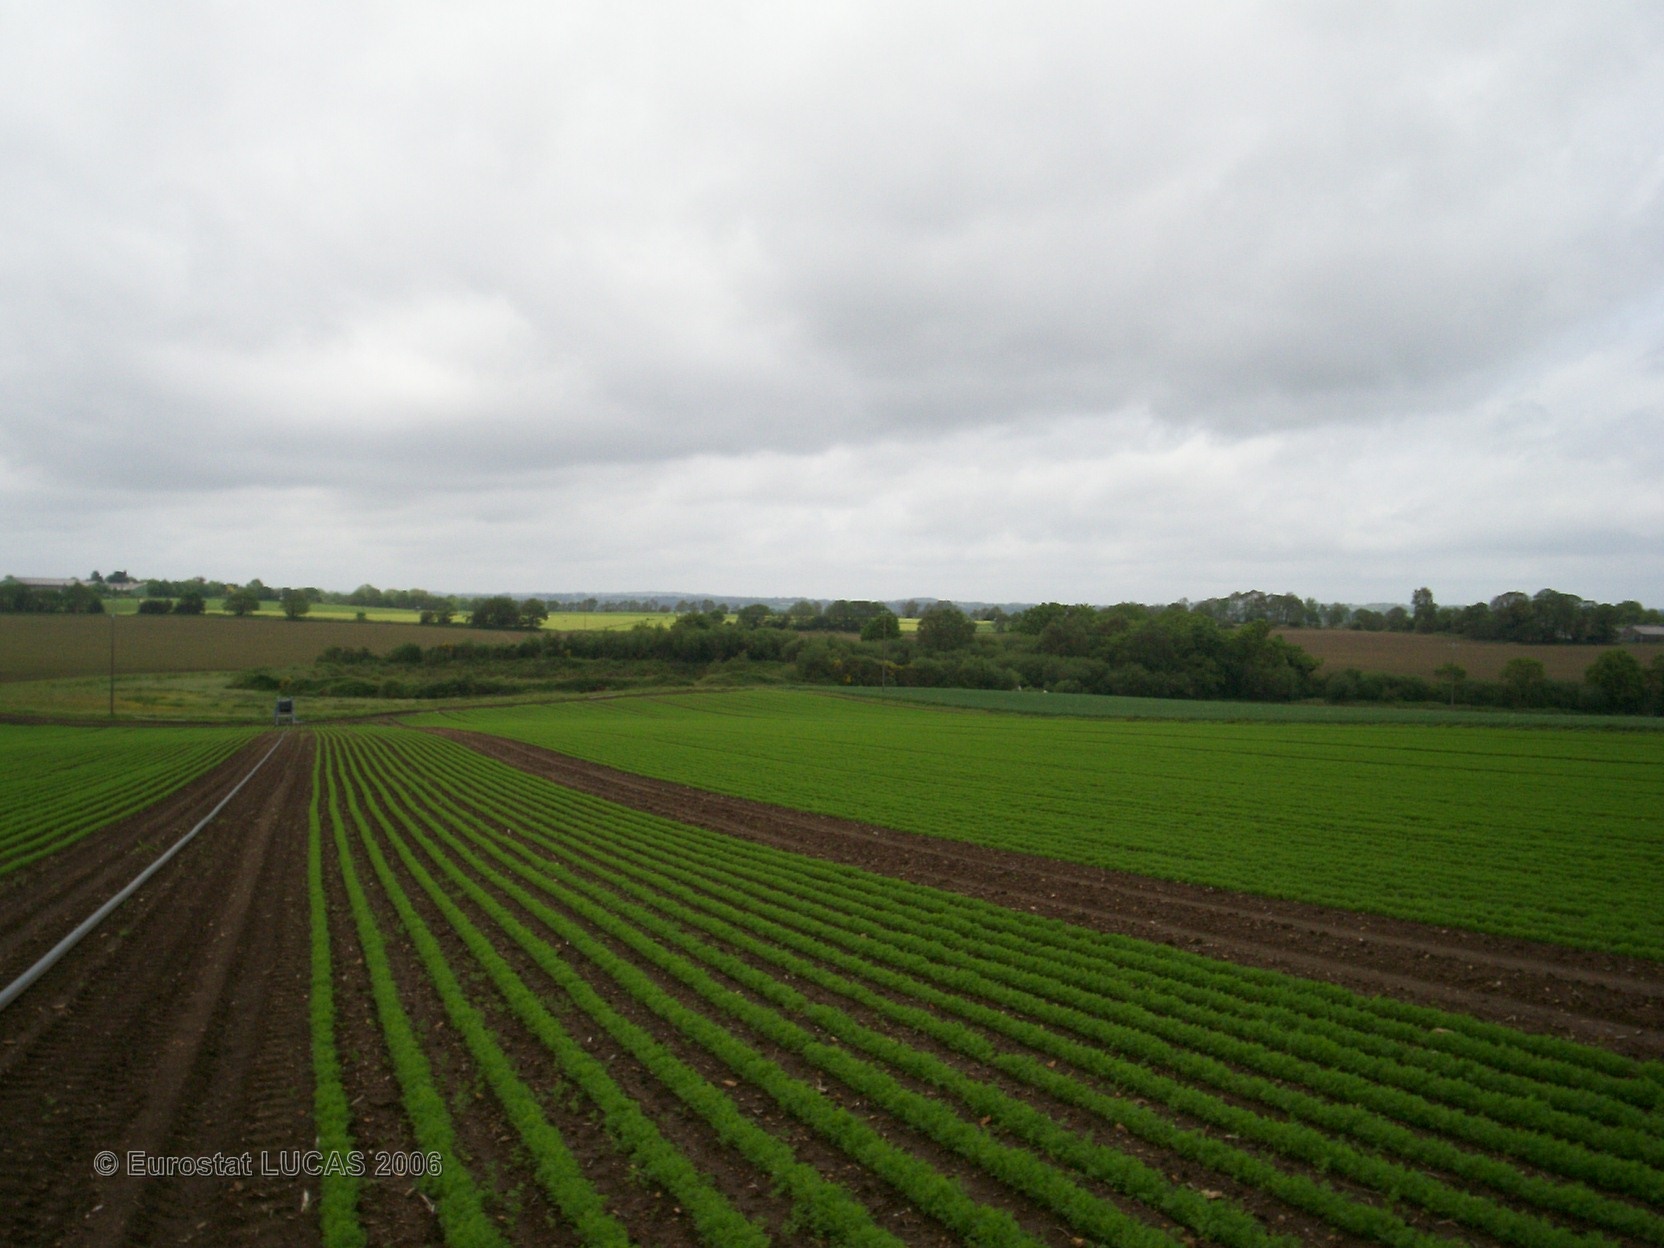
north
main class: Cropland
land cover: Other fresh vegetables
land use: Agriculture (excluding fallow land and kitchen gardens)
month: May
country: FR
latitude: 47.9079
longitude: -3.5768
